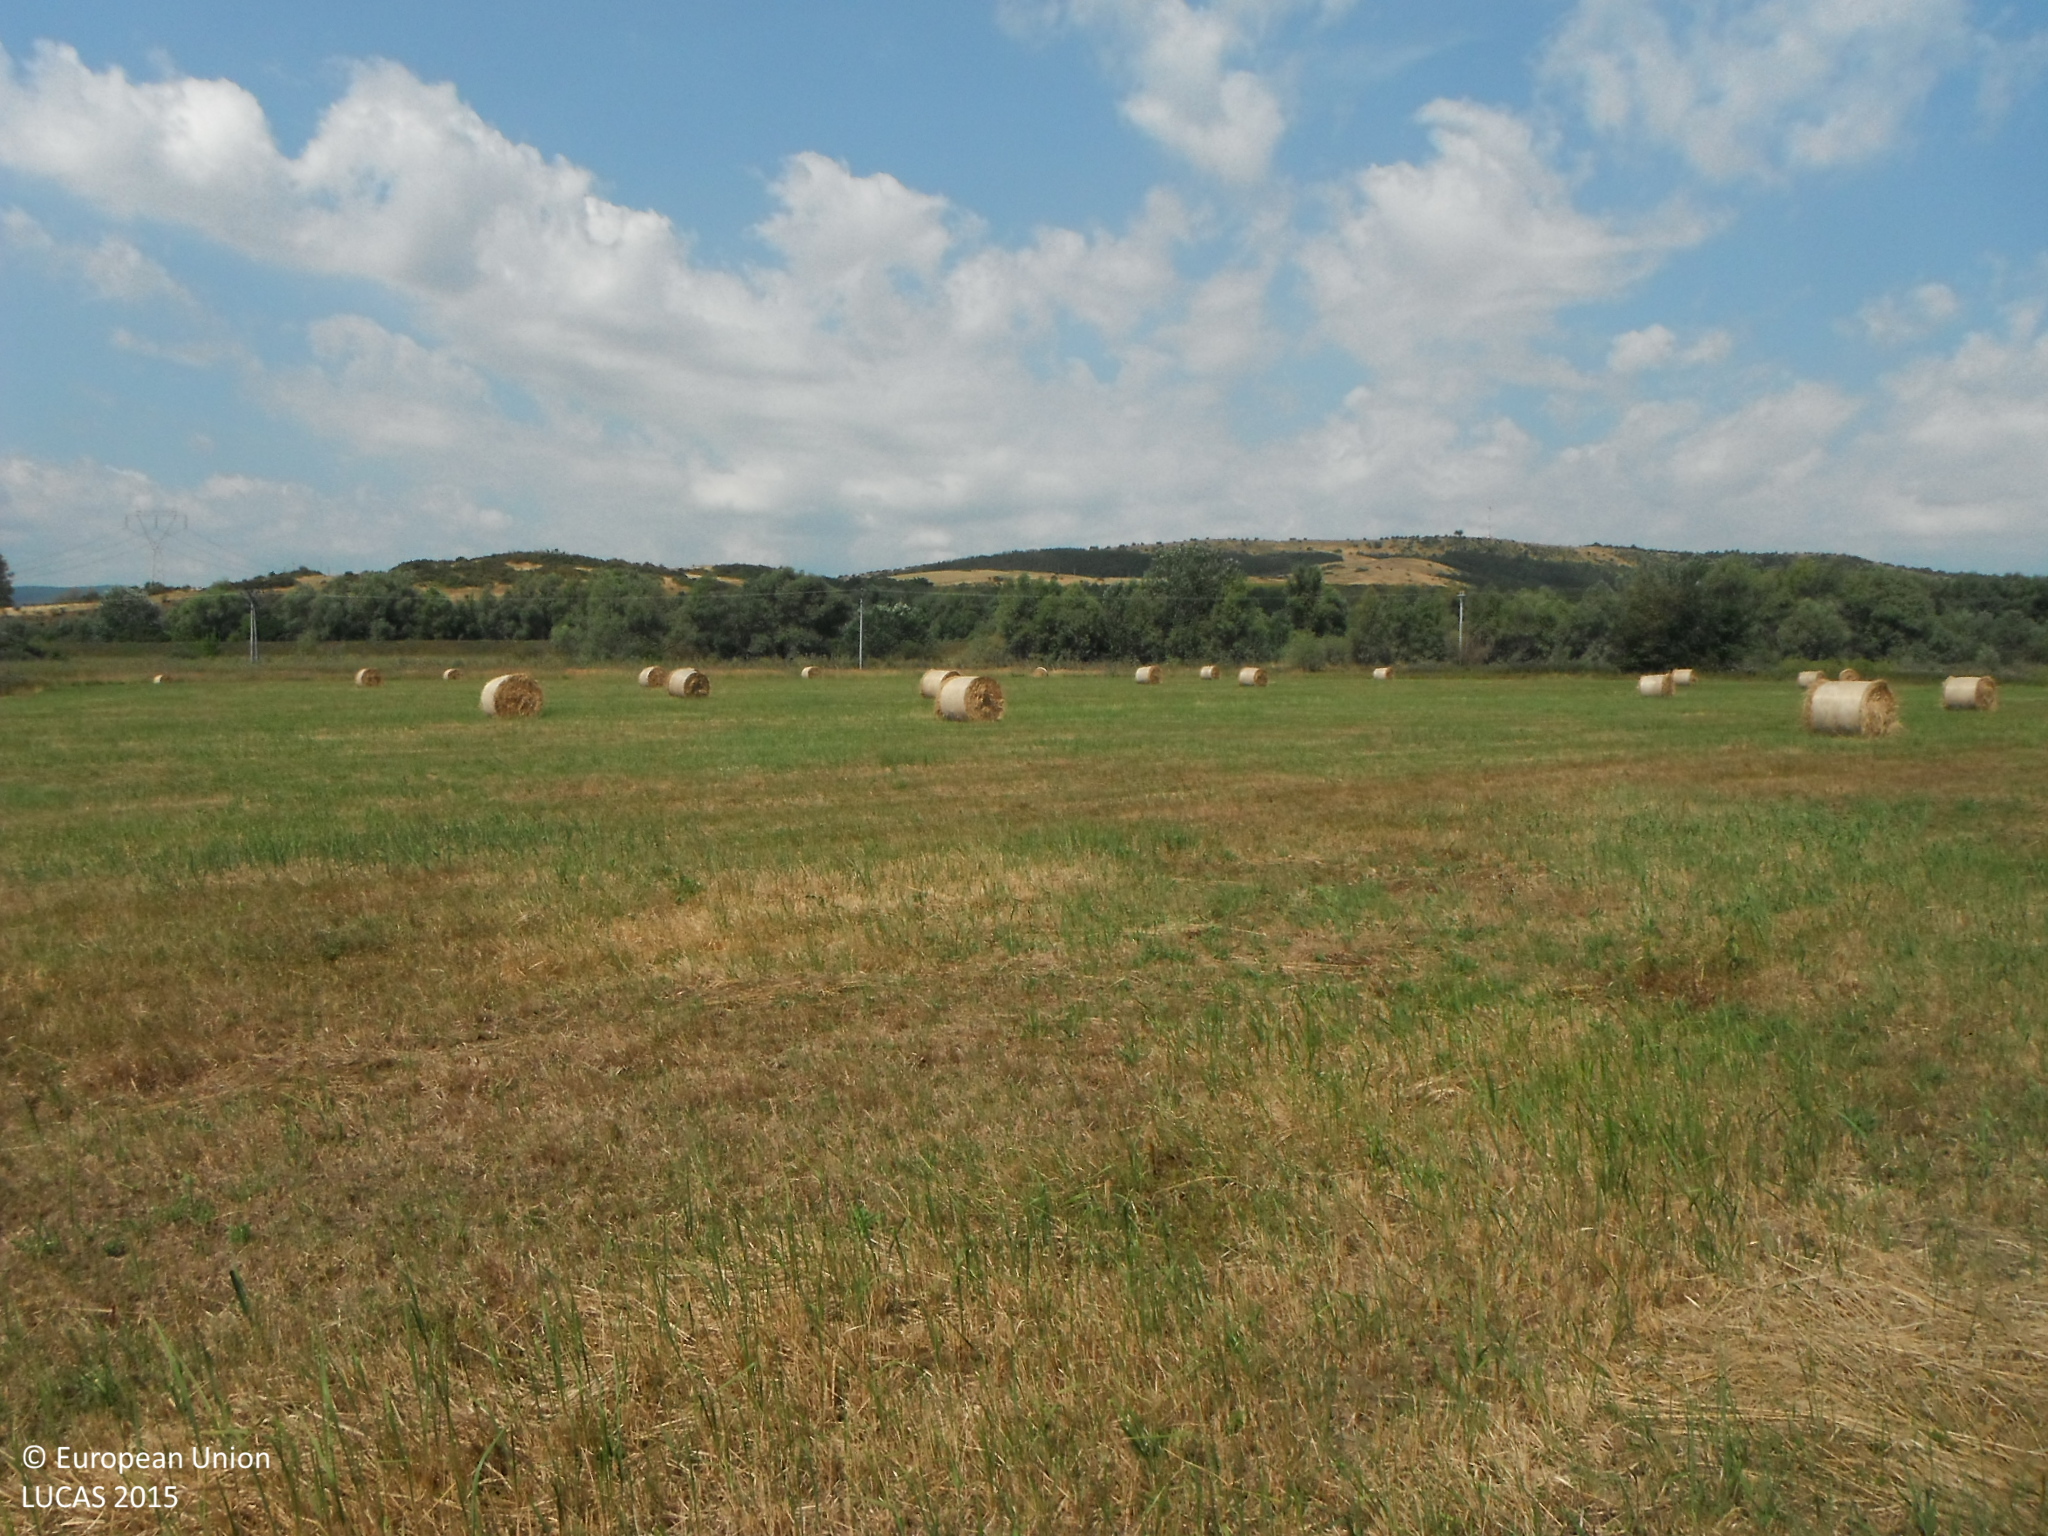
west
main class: Grassland
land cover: Grassland without tree/shrub cover
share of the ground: > 75 %
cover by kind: herbaceous plants 100 %
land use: Agriculture (excluding fallow land and kitchen gardens)
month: July
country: SK
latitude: 48.5130
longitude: 21.8152
